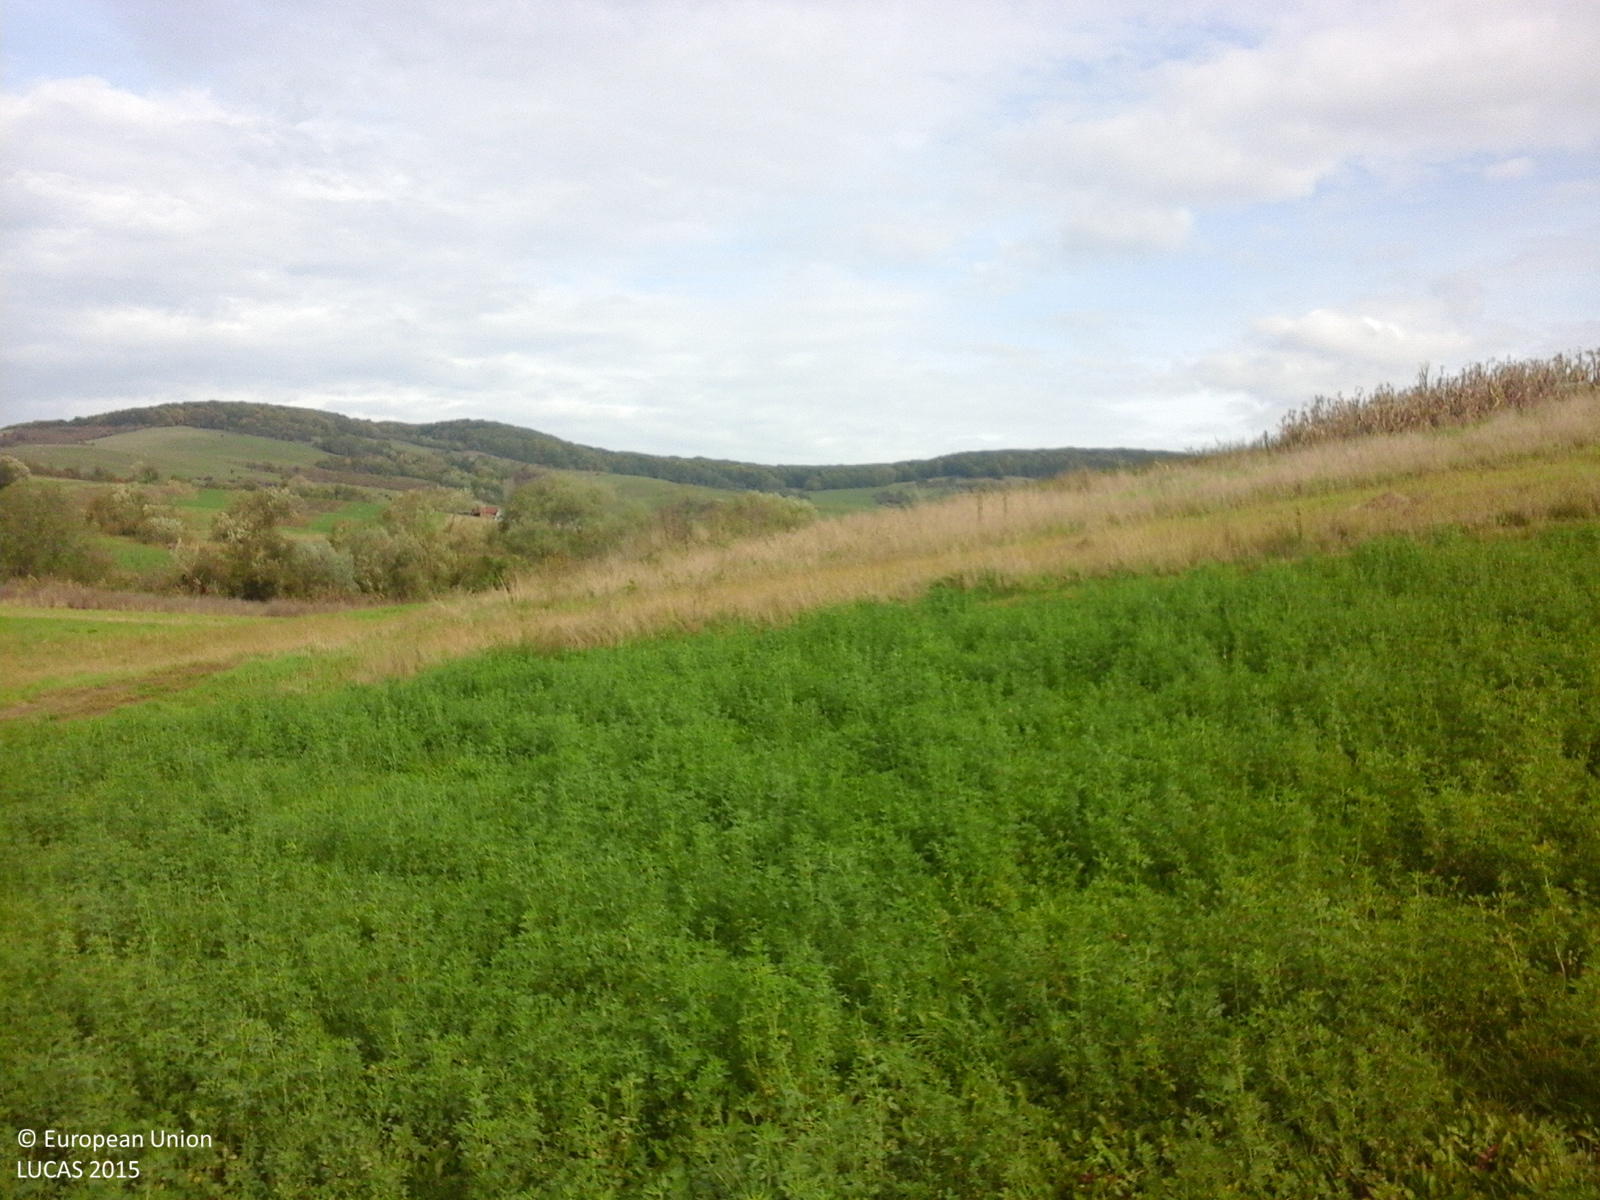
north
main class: Cropland
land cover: Lucerne
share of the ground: > 75 %
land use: Agriculture (excluding fallow land and kitchen gardens)
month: October
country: RO
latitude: 46.1991
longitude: 25.1438
